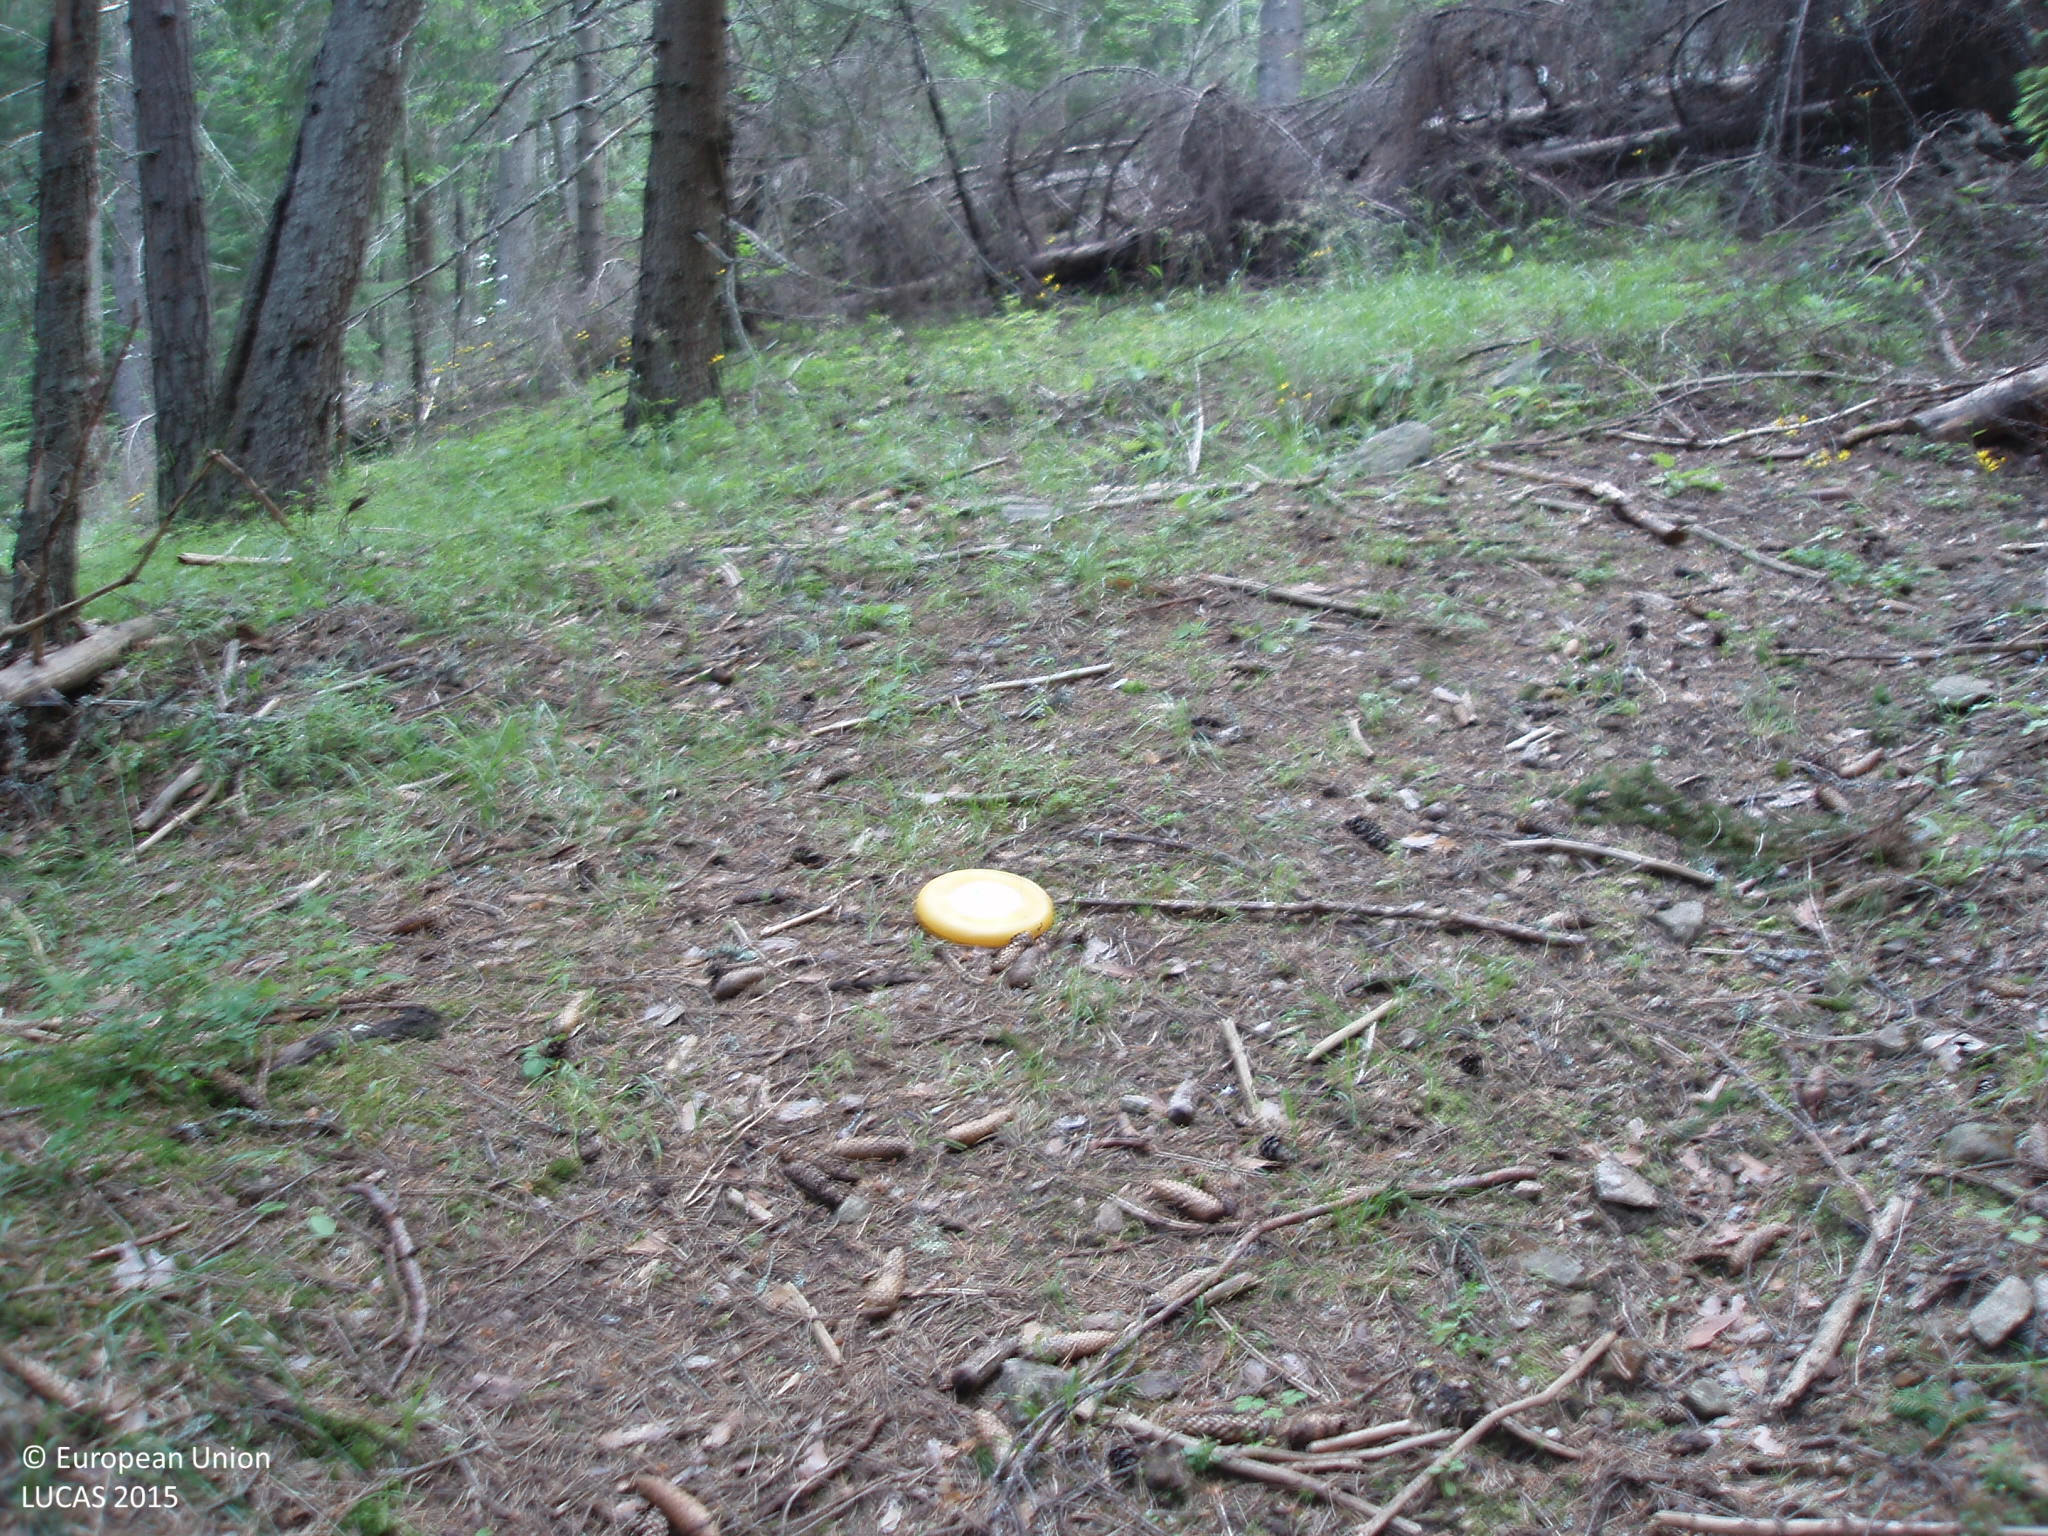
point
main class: Woodland
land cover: Spruce dominated coniferous woodland
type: hemiboreal forest and nemoral coniferous forest and mixed broadleaved-coniferous forest
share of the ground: > 75 %
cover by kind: coniferous forest trees 100 %
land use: Forestry
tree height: > 5 m
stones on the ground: 25 - 50 %
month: July
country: BG
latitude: 42.1010
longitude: 23.7098
